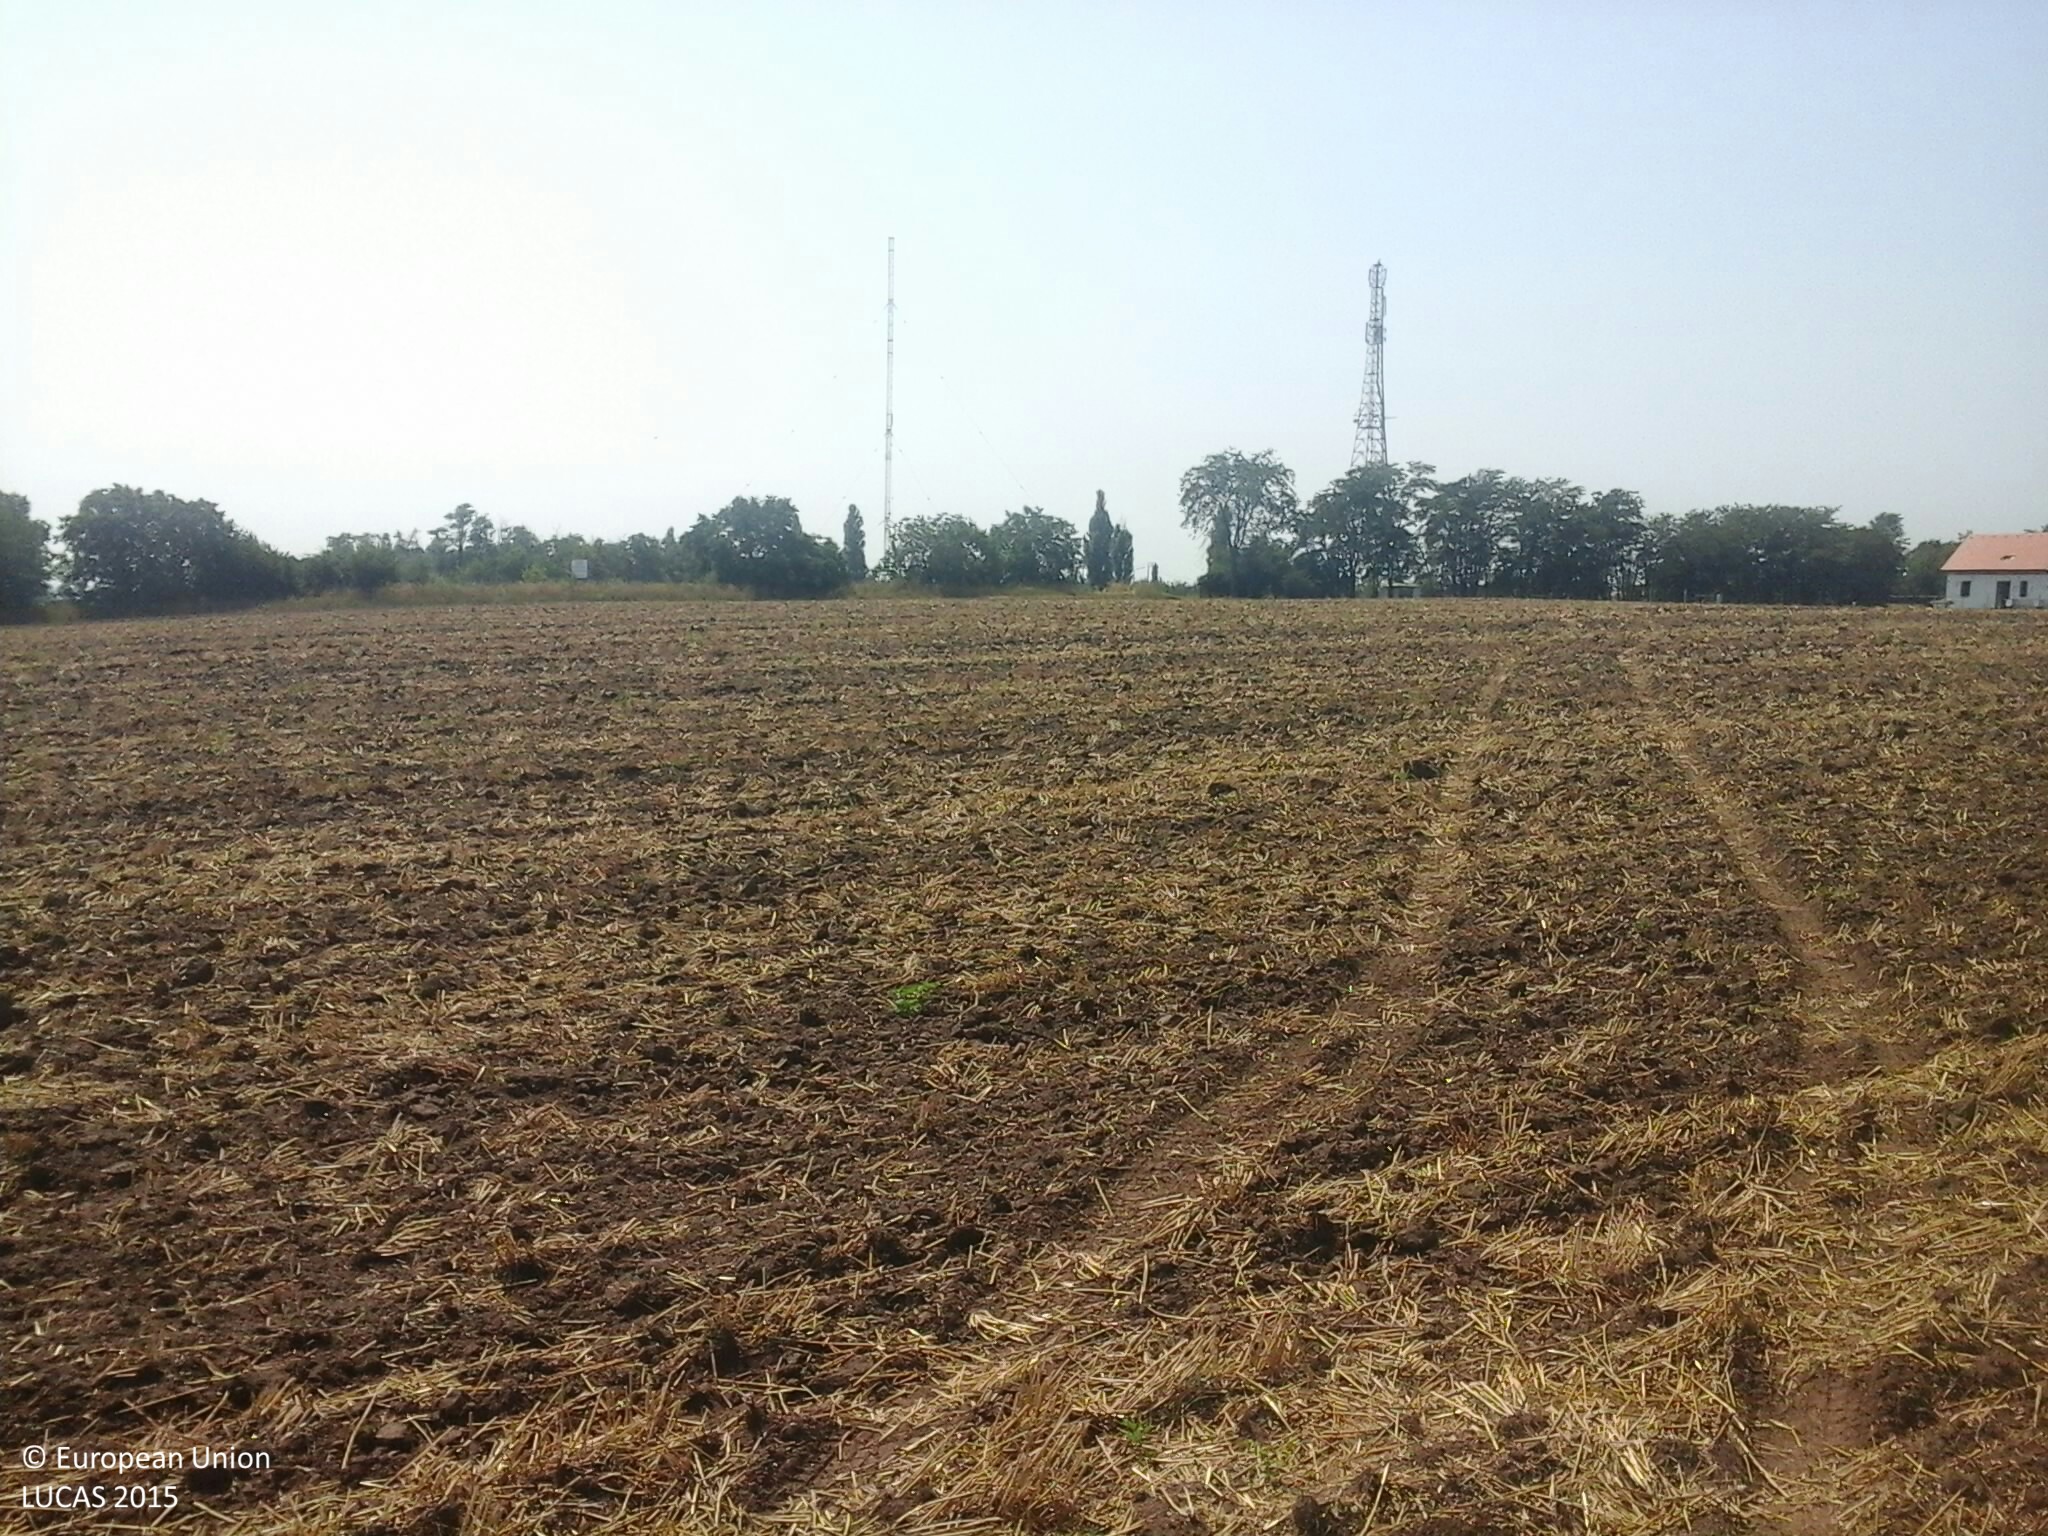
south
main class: Cropland
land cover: Common wheat
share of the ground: > 75 %
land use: Agriculture (excluding fallow land and kitchen gardens)
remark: Harvested field
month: August
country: HU
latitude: 46.9293
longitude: 18.1131
